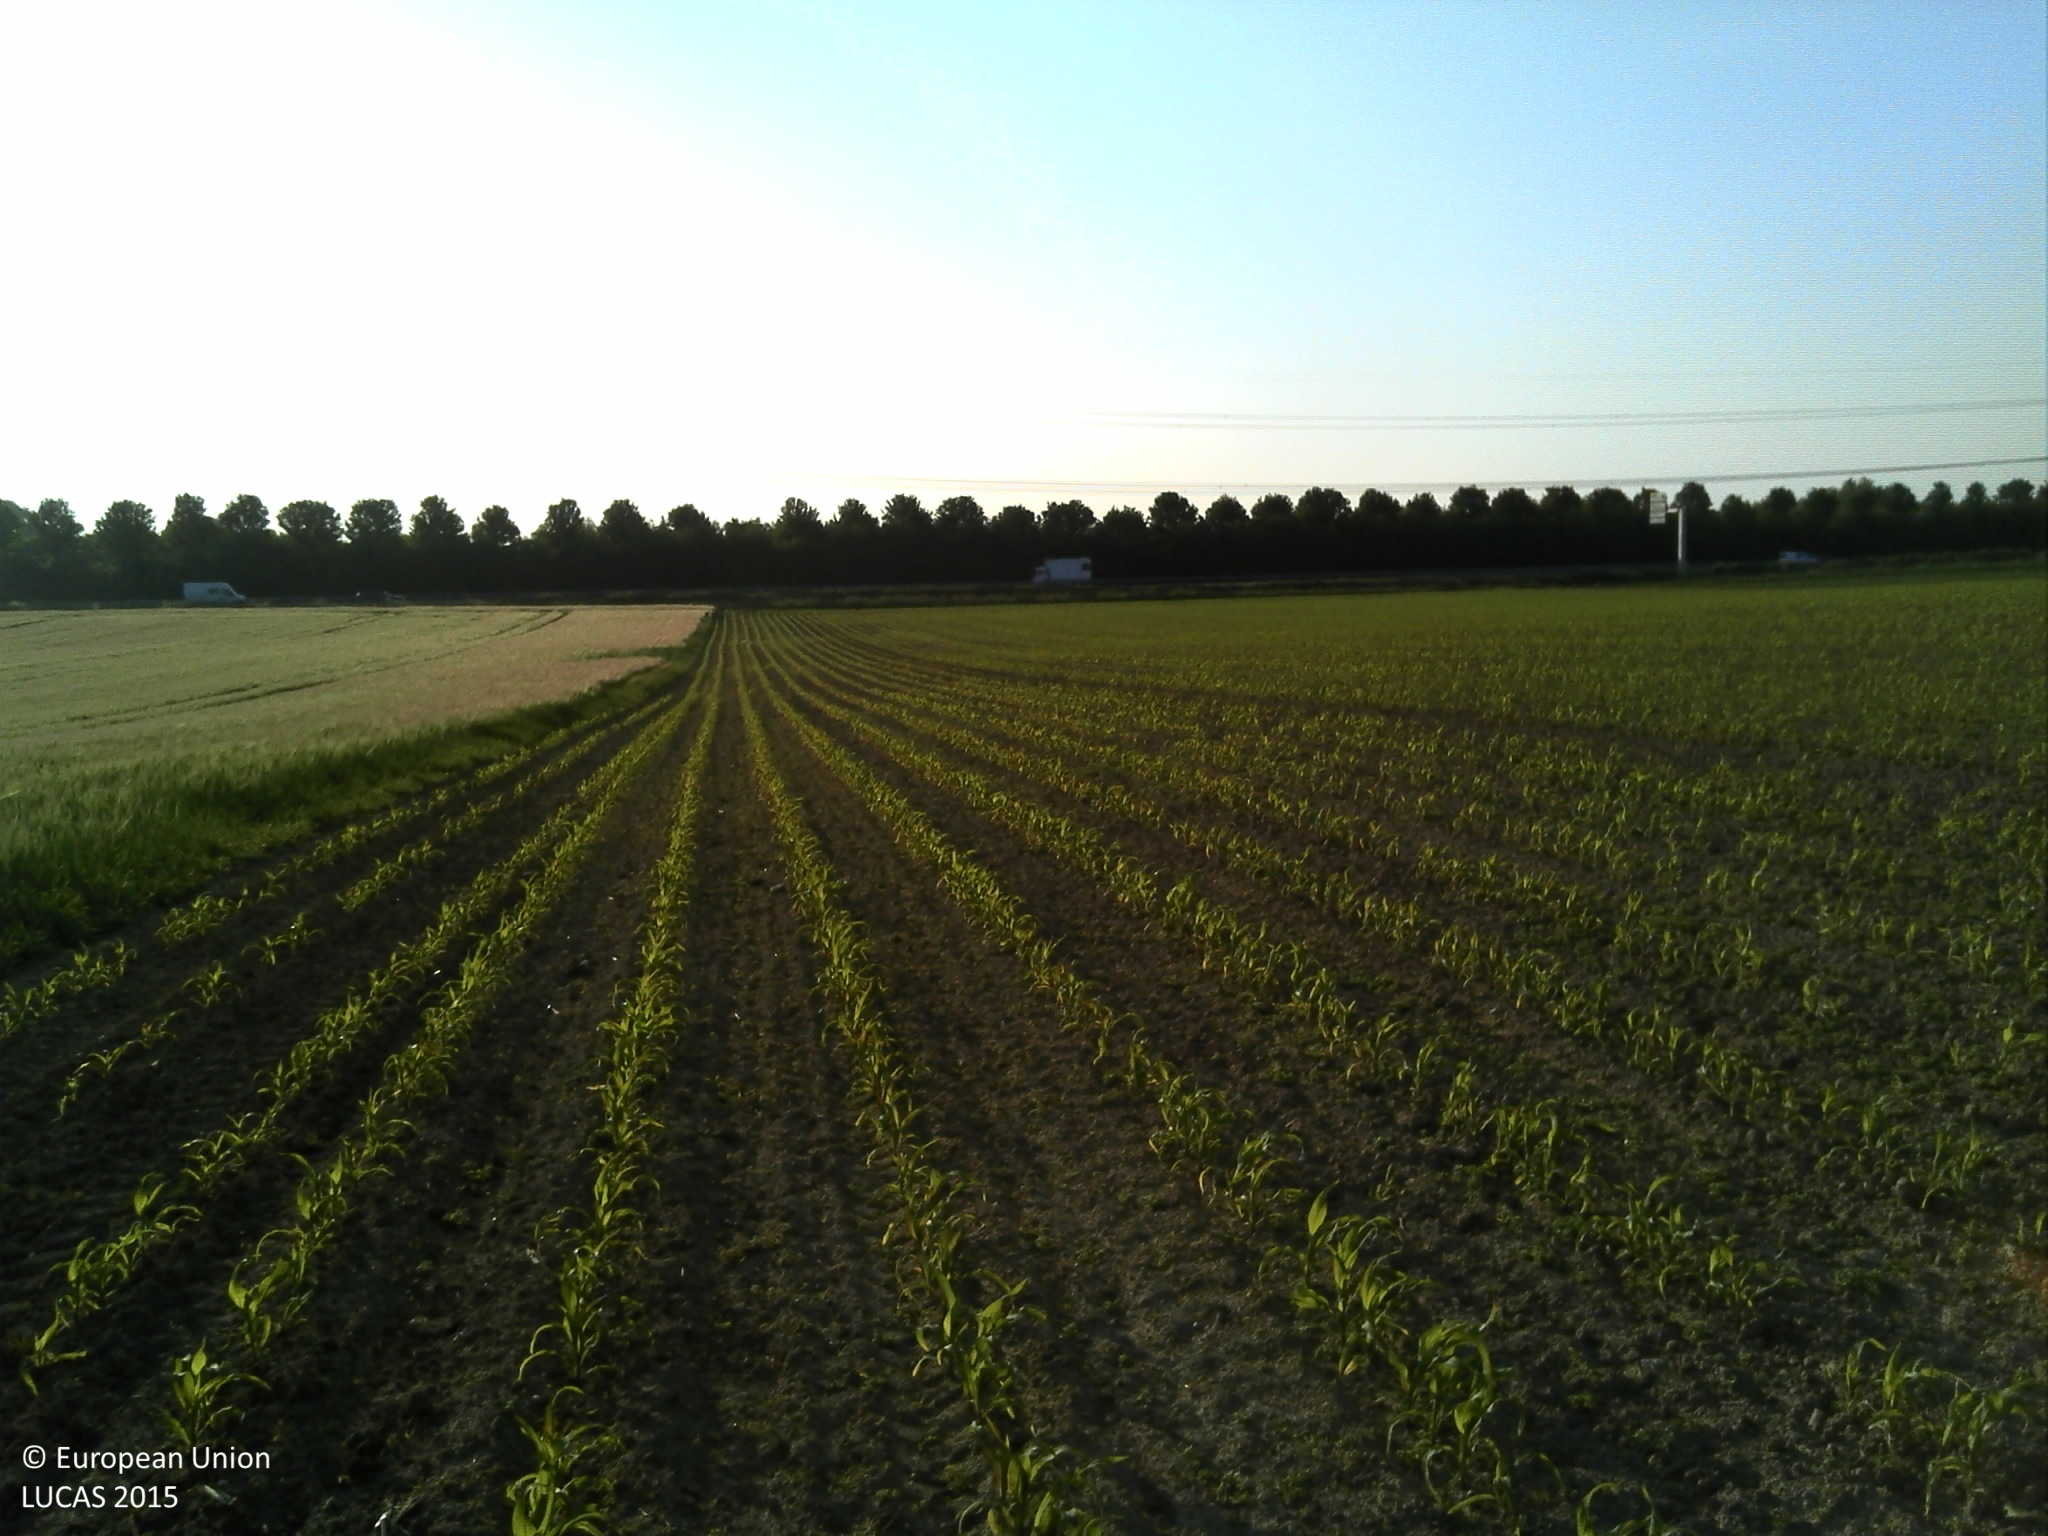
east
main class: Cropland
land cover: Maize
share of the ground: < 10 %
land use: Agriculture (excluding fallow land and kitchen gardens)
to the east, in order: Maize; Grass margins; Tracks; Spontaneously vegetated surfaces; Paved roads, cycling and walking lanes; Grass margins; Lines of trees; Spontaneously vegetated surfaces; Tracks
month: June
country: FR
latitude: 49.7238
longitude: 1.0585
